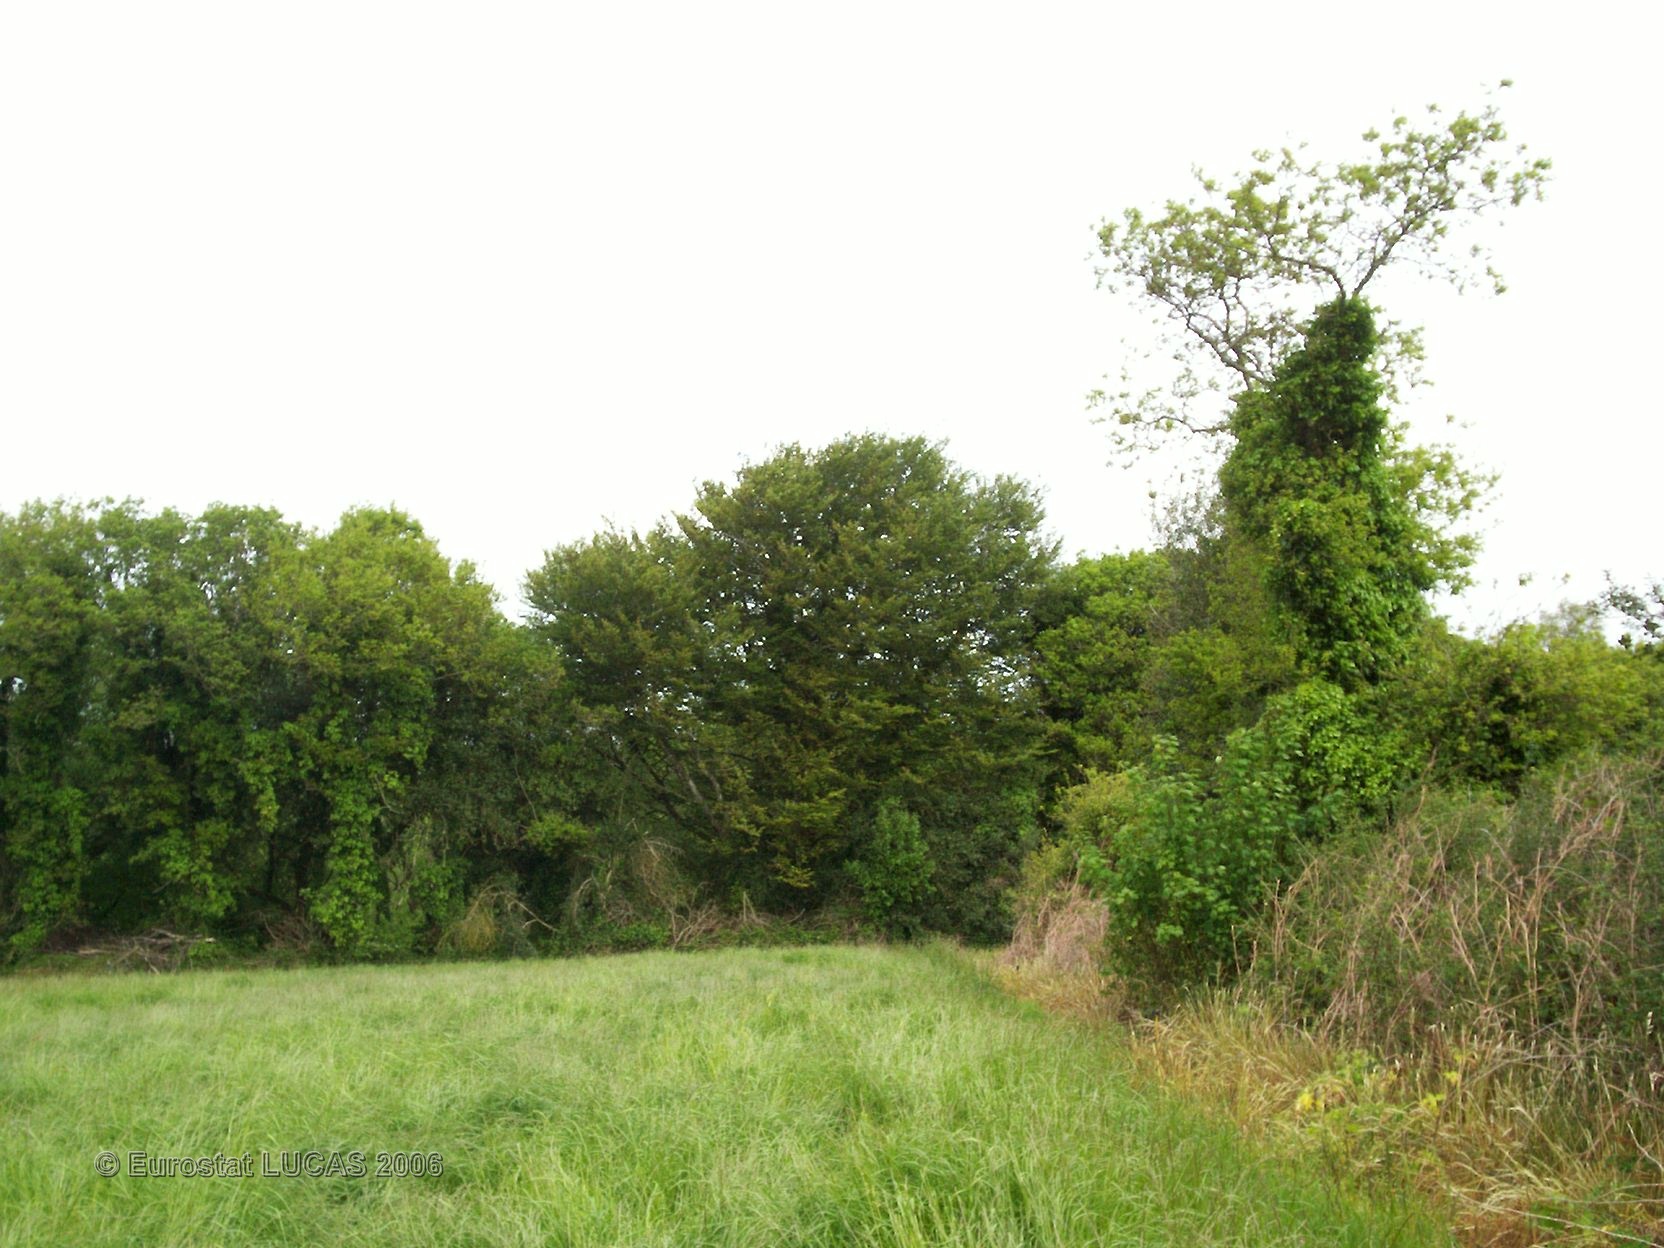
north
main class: Grassland
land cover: Grassland without tree/shrub cover
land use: Agriculture (excluding fallow land and kitchen gardens)
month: May
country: FR
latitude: 47.9771
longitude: -3.8960
